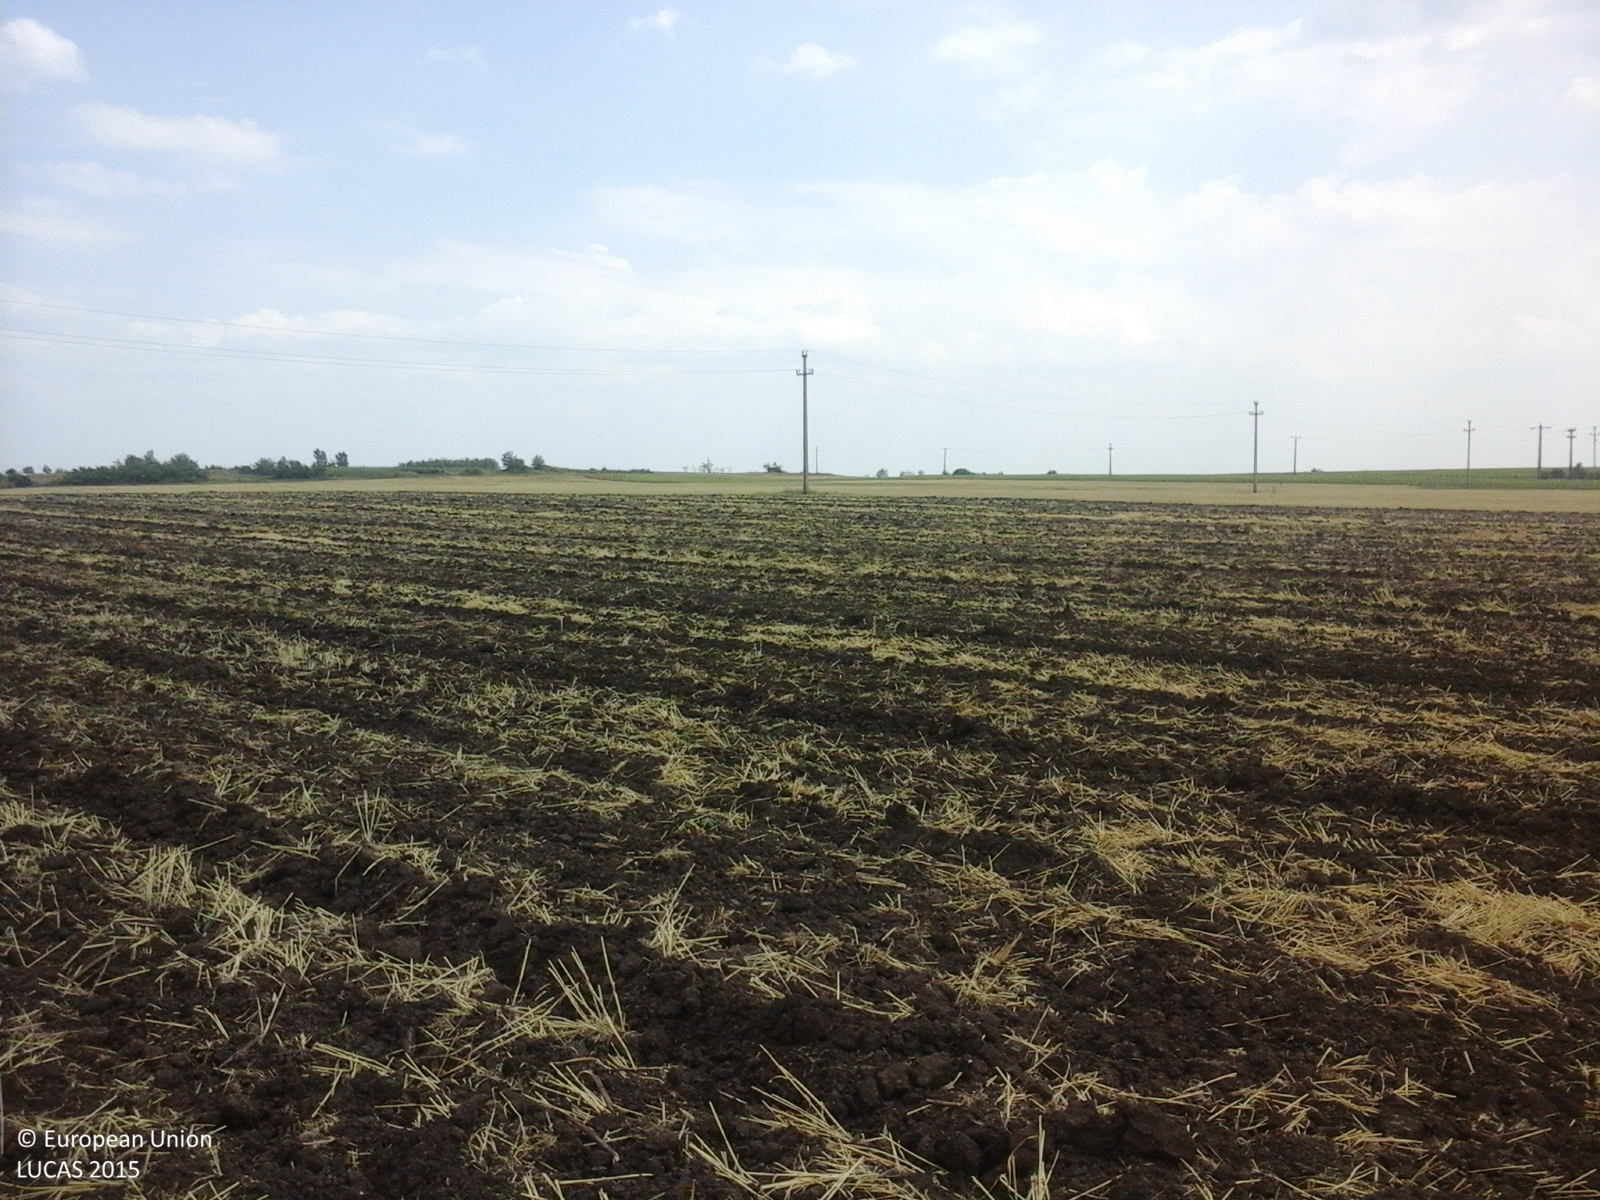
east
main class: Cropland
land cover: Common wheat
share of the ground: 10 - 25 %
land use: Agriculture (excluding fallow land and kitchen gardens)
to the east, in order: Common wheat; Electric lines; Common wheat
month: July
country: RO
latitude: 46.0614
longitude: 28.0004
